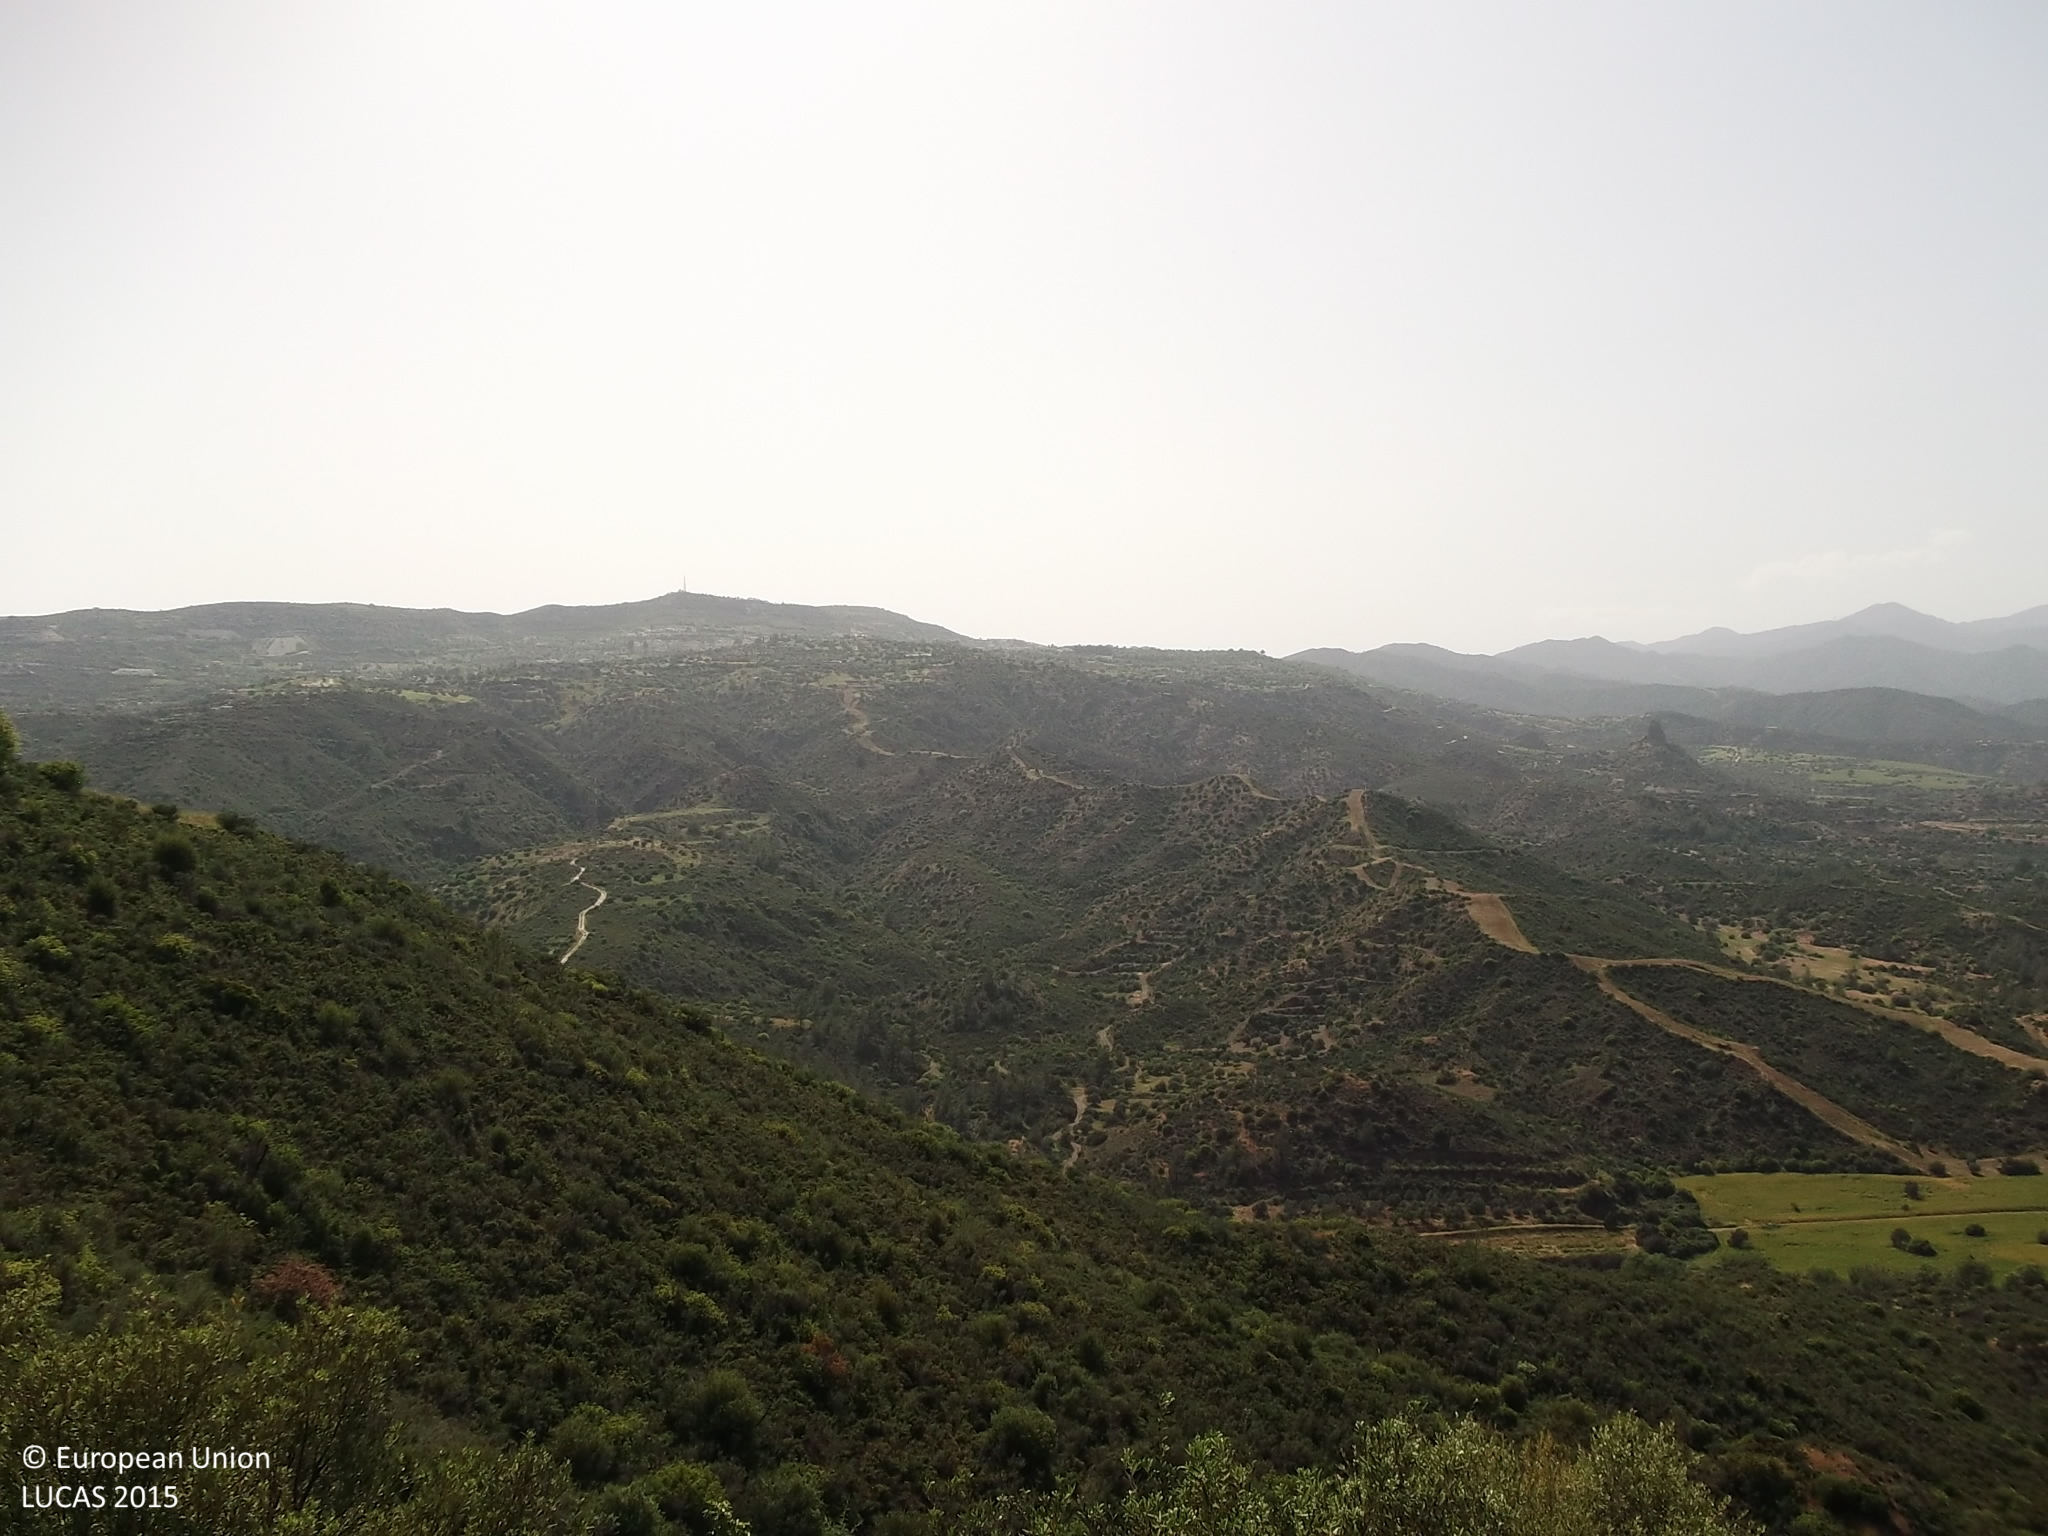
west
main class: Shrubland
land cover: Shrubland with sparse tree cover
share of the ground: > 75 %
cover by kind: shrubs 95 %, broadleaved forest trees 5 %
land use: Semi-natural and natural areas not in use
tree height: < 5 m
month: April
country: CY
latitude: 34.8744
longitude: 33.3434
